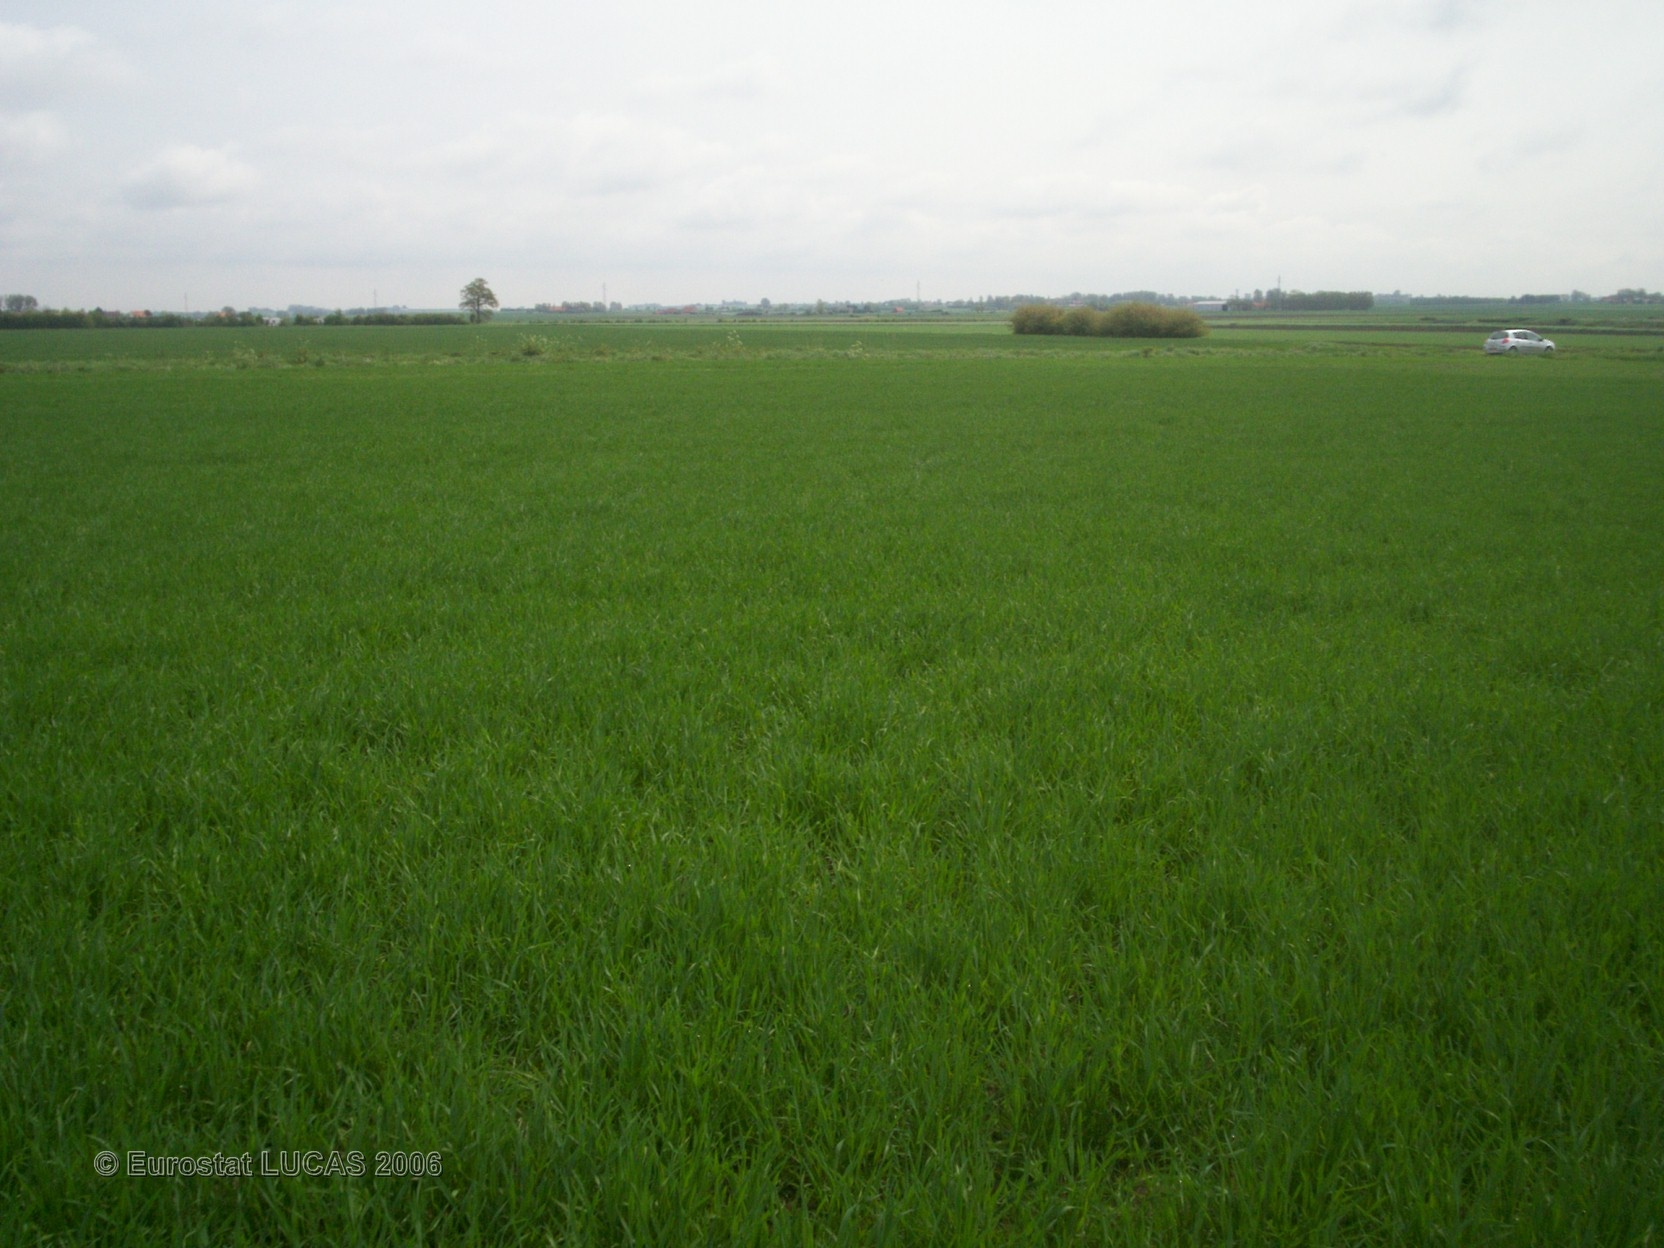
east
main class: Cropland
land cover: Common wheat
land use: Agriculture (excluding fallow land and kitchen gardens)
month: May
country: FR
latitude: 50.8987
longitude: 2.2937
